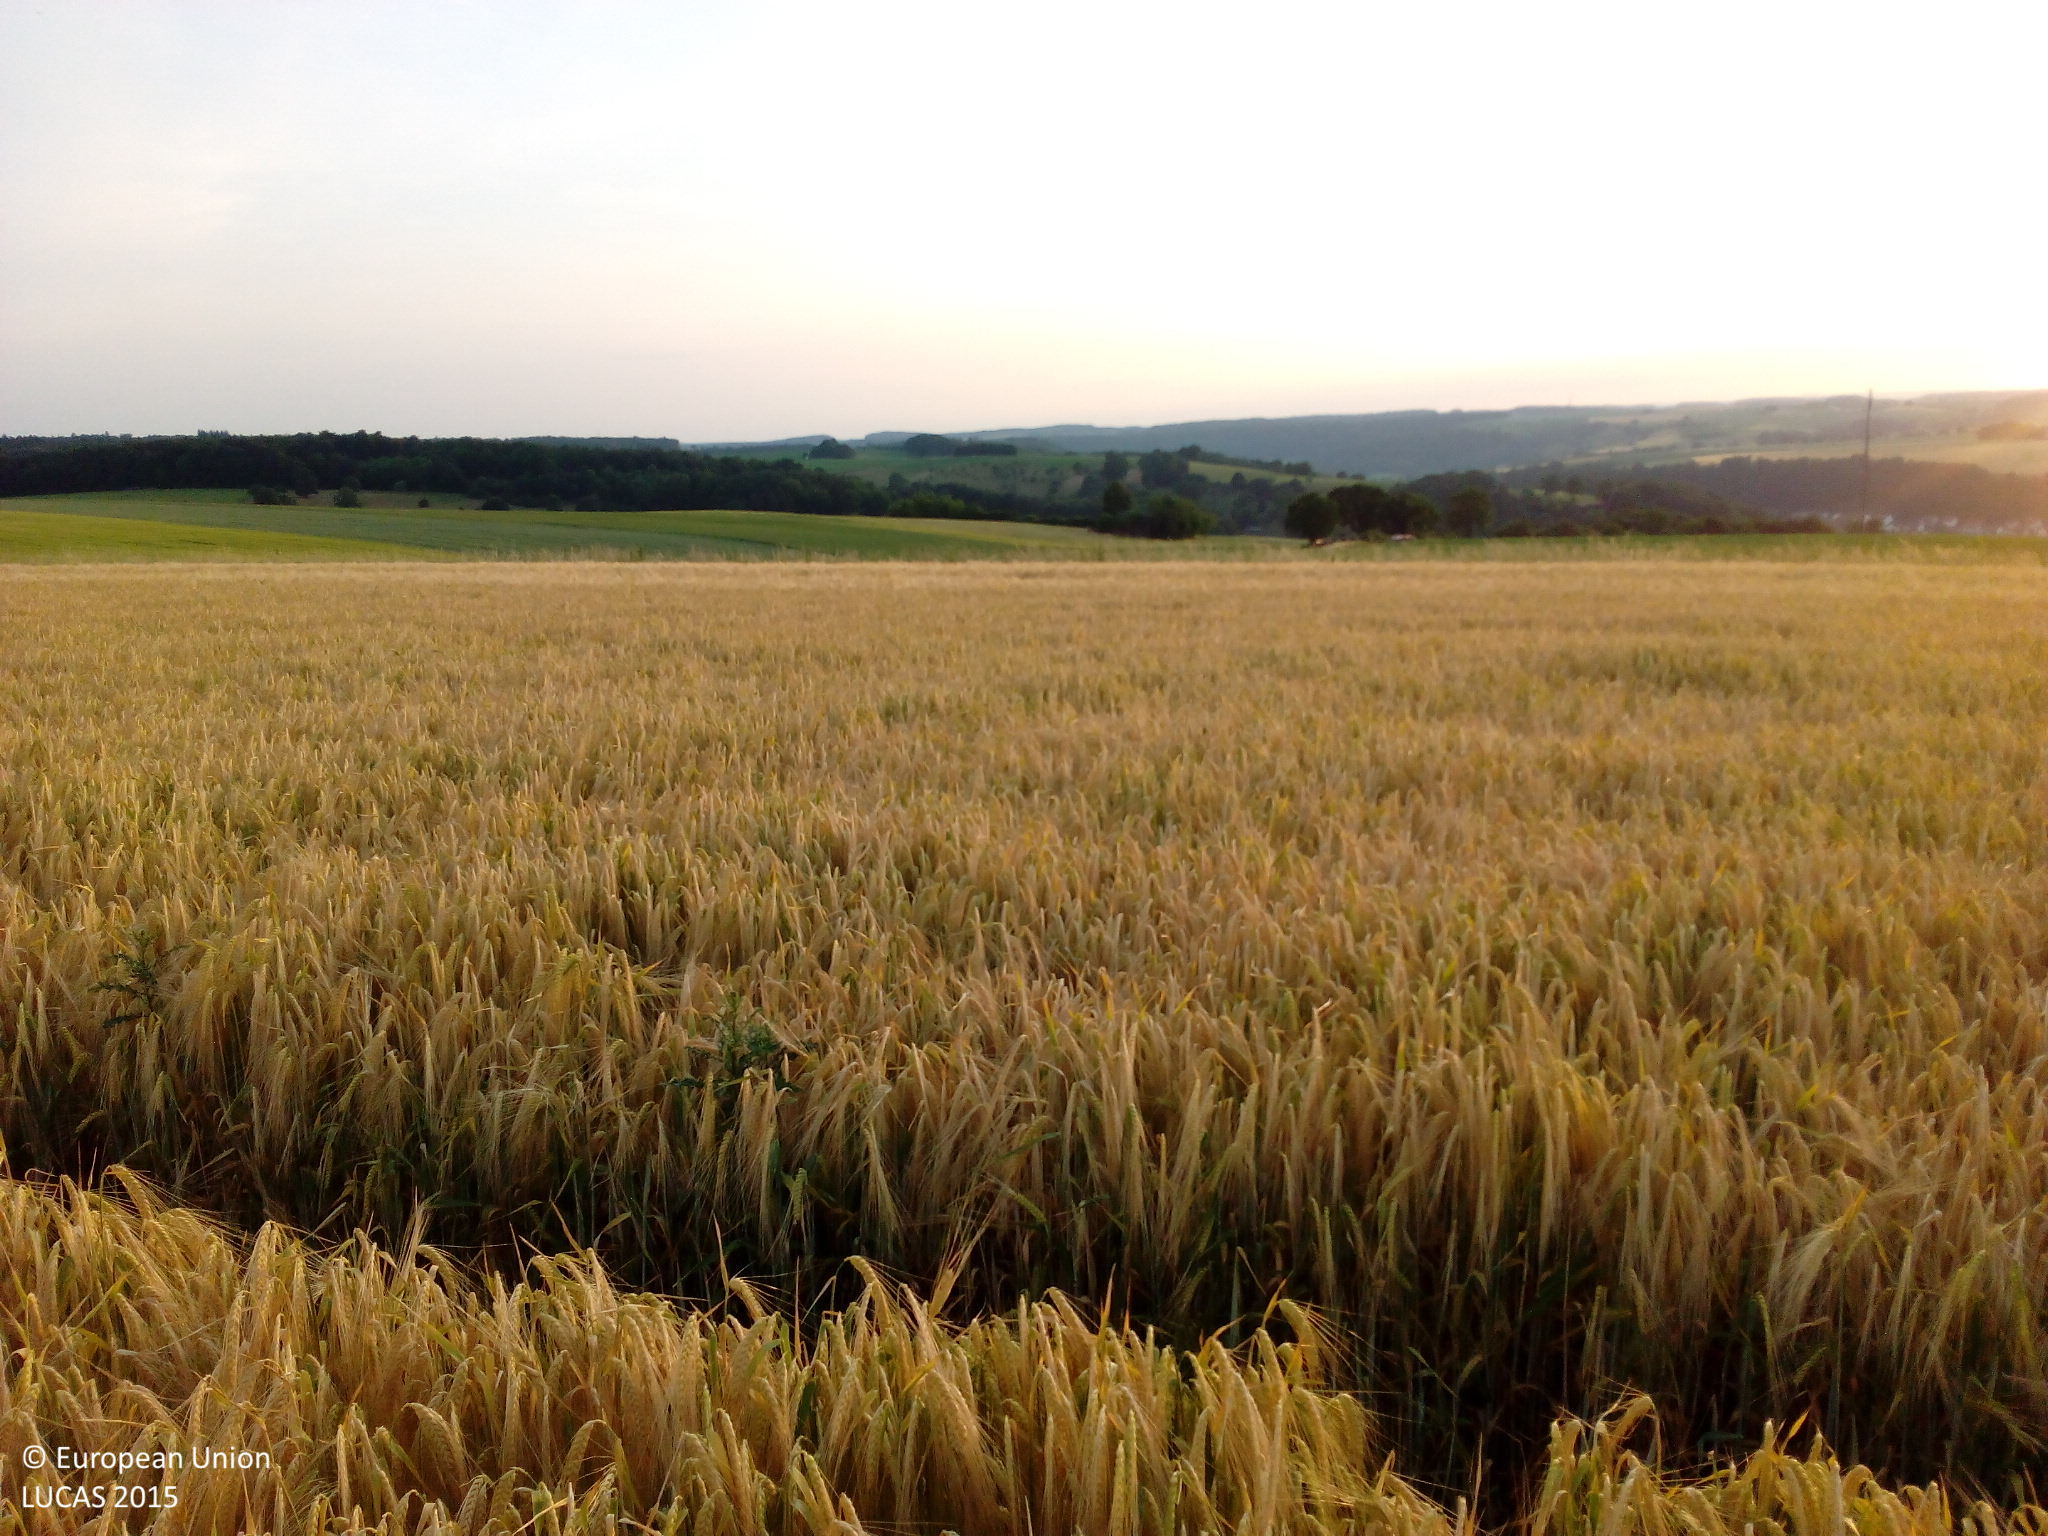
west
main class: Cropland
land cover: Barley
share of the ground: > 75 %
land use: Agriculture (excluding fallow land and kitchen gardens)
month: June
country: DE
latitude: 49.3381
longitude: 9.5735
